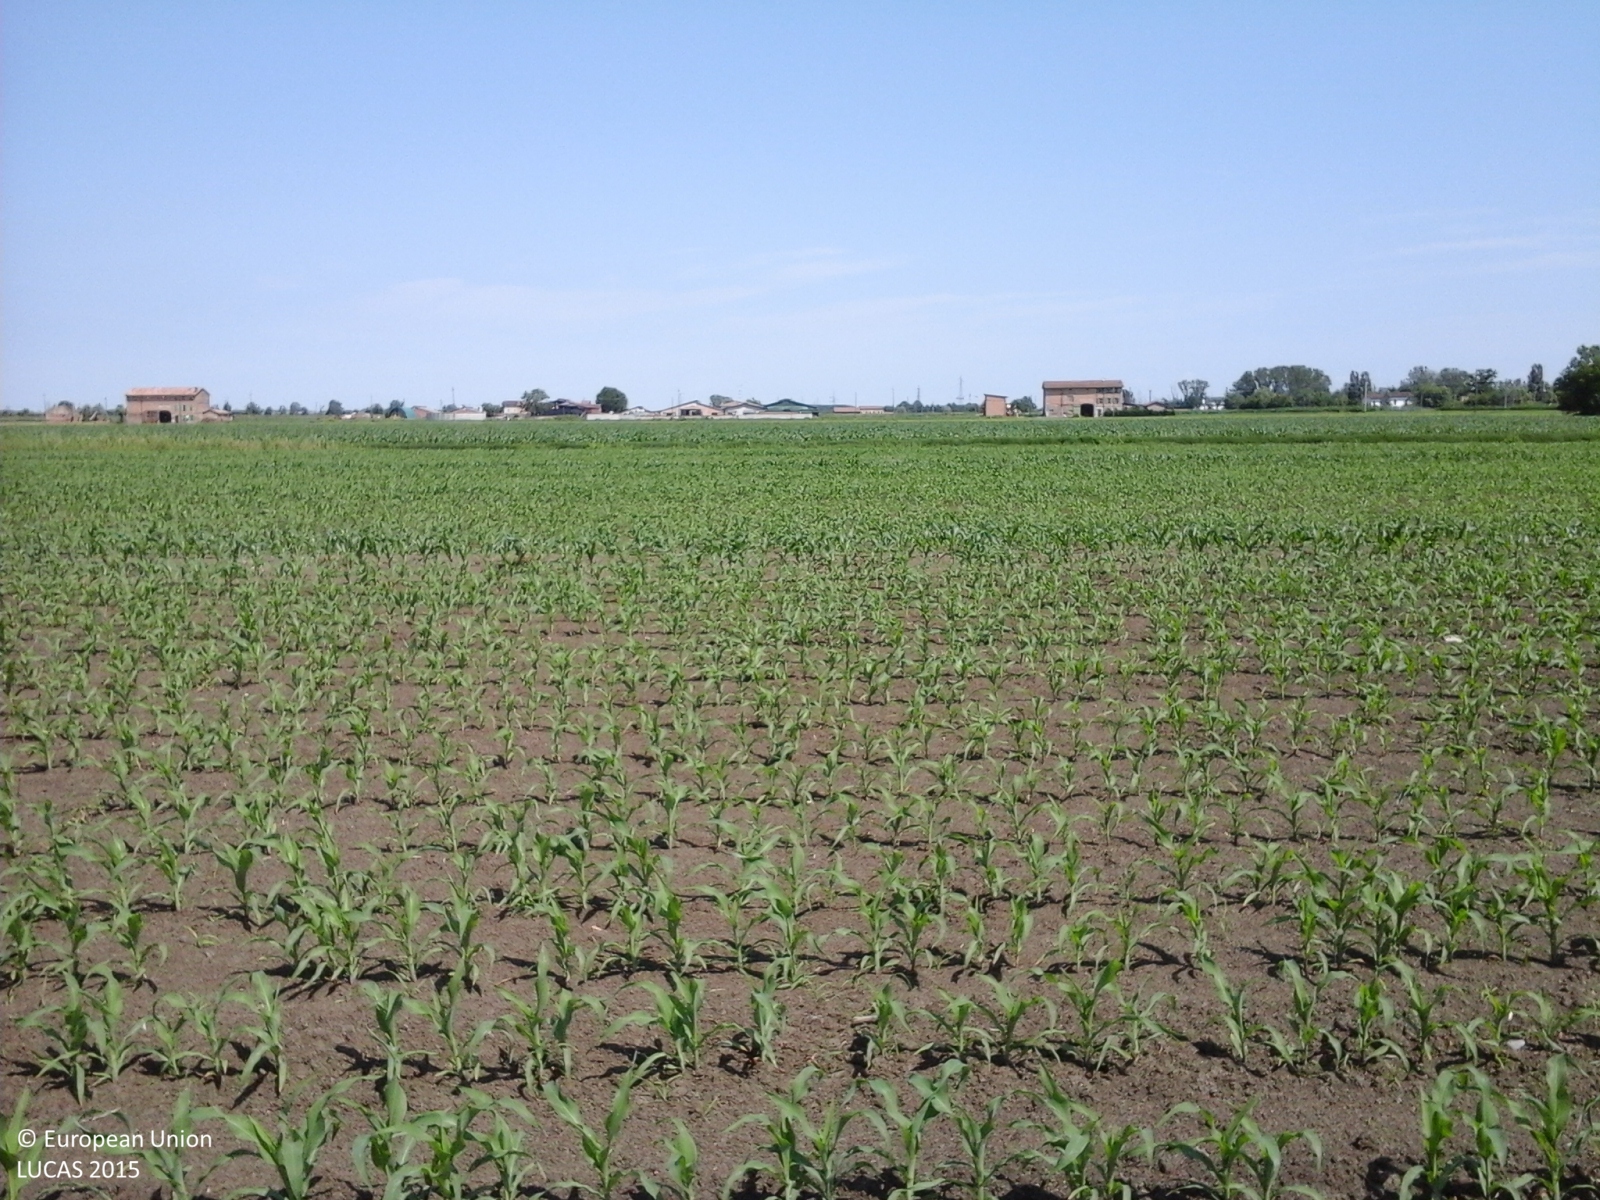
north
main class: Cropland
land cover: Maize
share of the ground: < 10 %
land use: Agriculture (excluding fallow land and kitchen gardens)
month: May
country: IT
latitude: 44.8717
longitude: 10.6190
